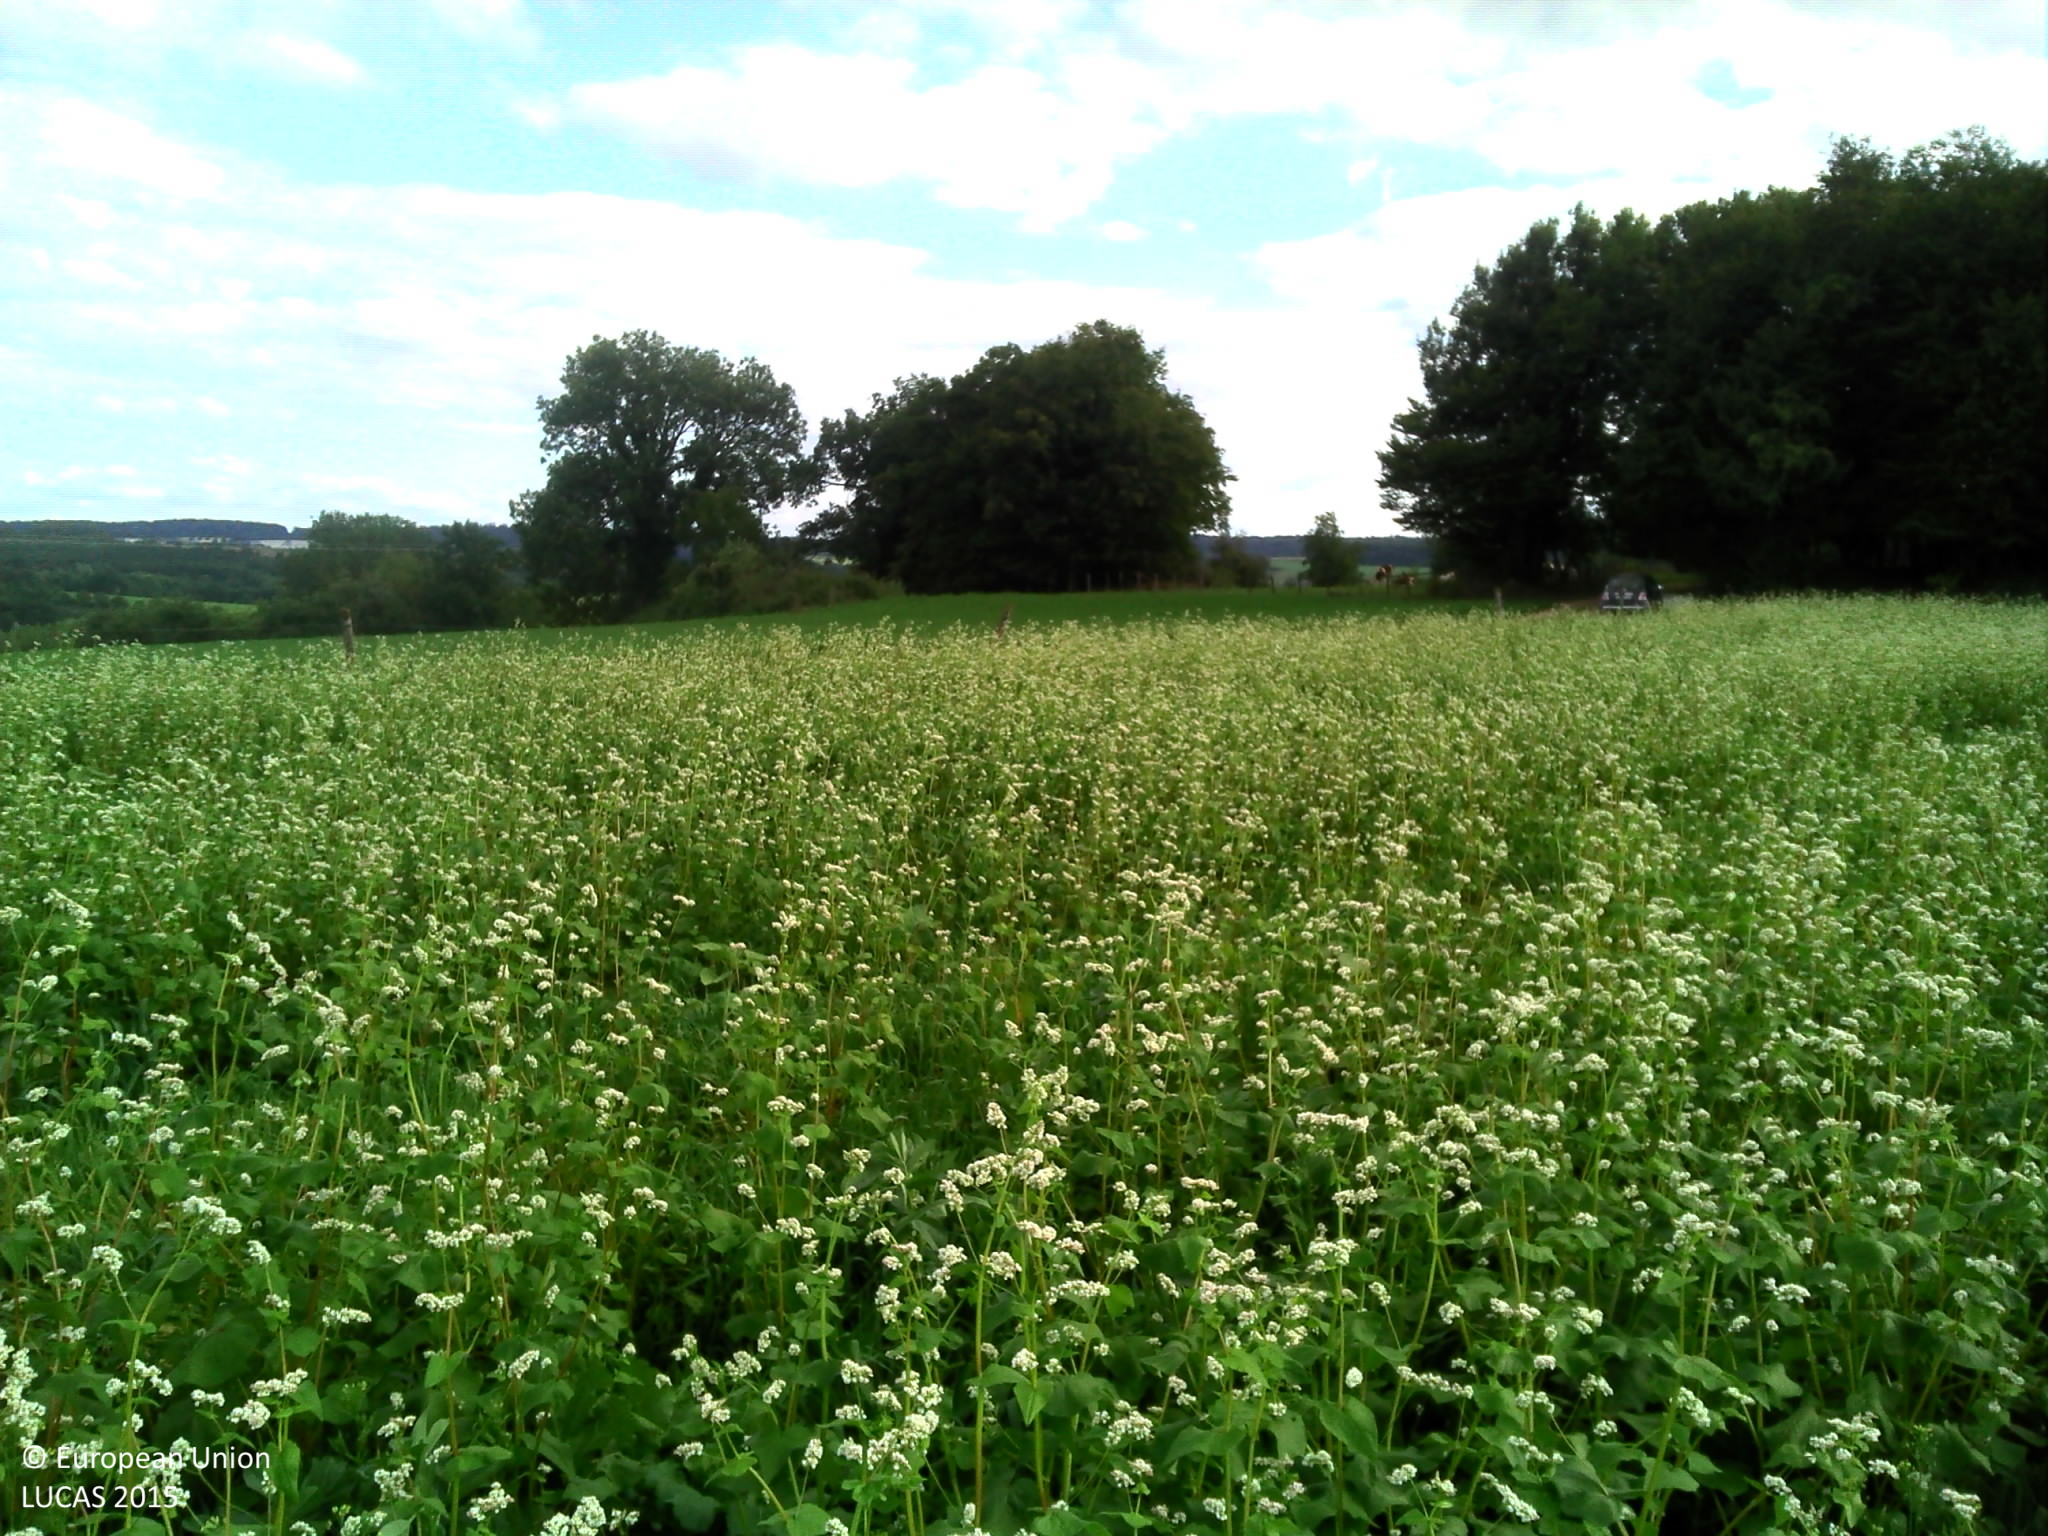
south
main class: Cropland
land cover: Other cereals
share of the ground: > 75 %
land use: Agriculture (excluding fallow land and kitchen gardens)
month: September
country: FR
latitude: 47.4067
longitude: 6.3574
